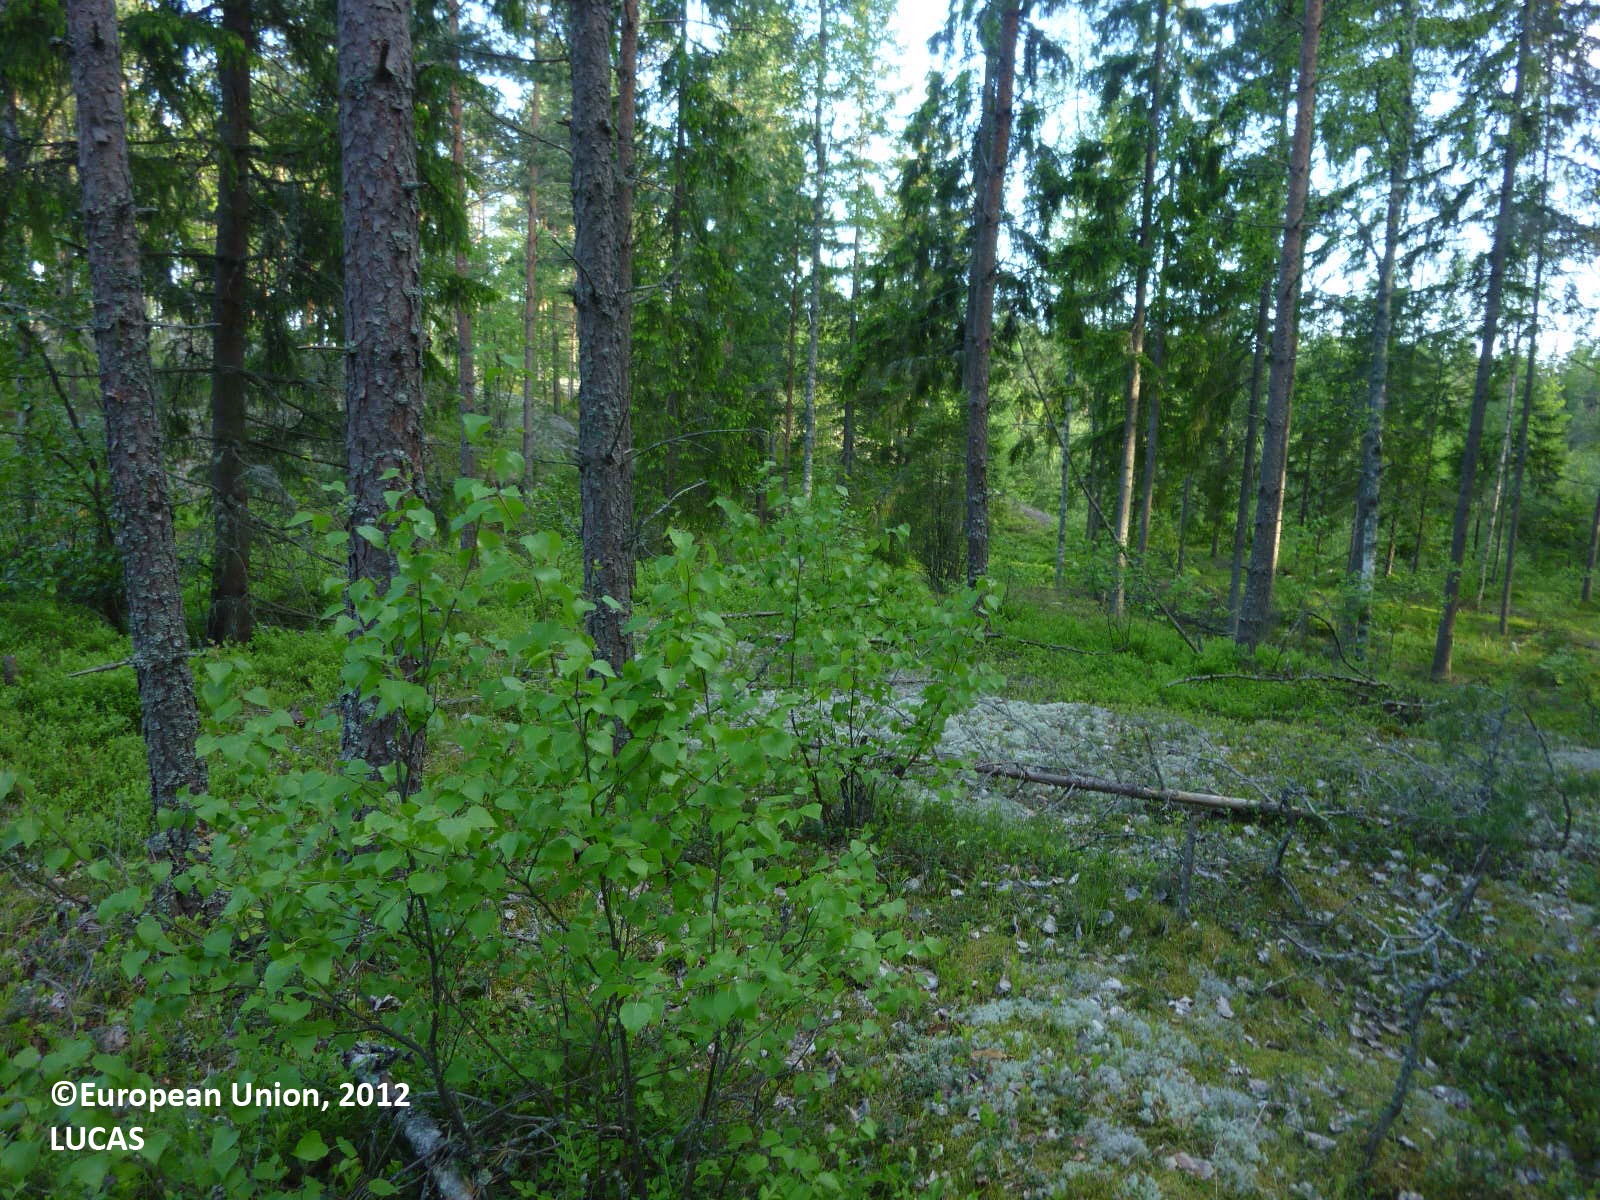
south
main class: Woodland
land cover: Pine dominated mixed woodland
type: boreal forest
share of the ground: 25 - 50 %
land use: Forestry
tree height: > 5 m
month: June
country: FI
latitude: 60.3441
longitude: 22.5926
